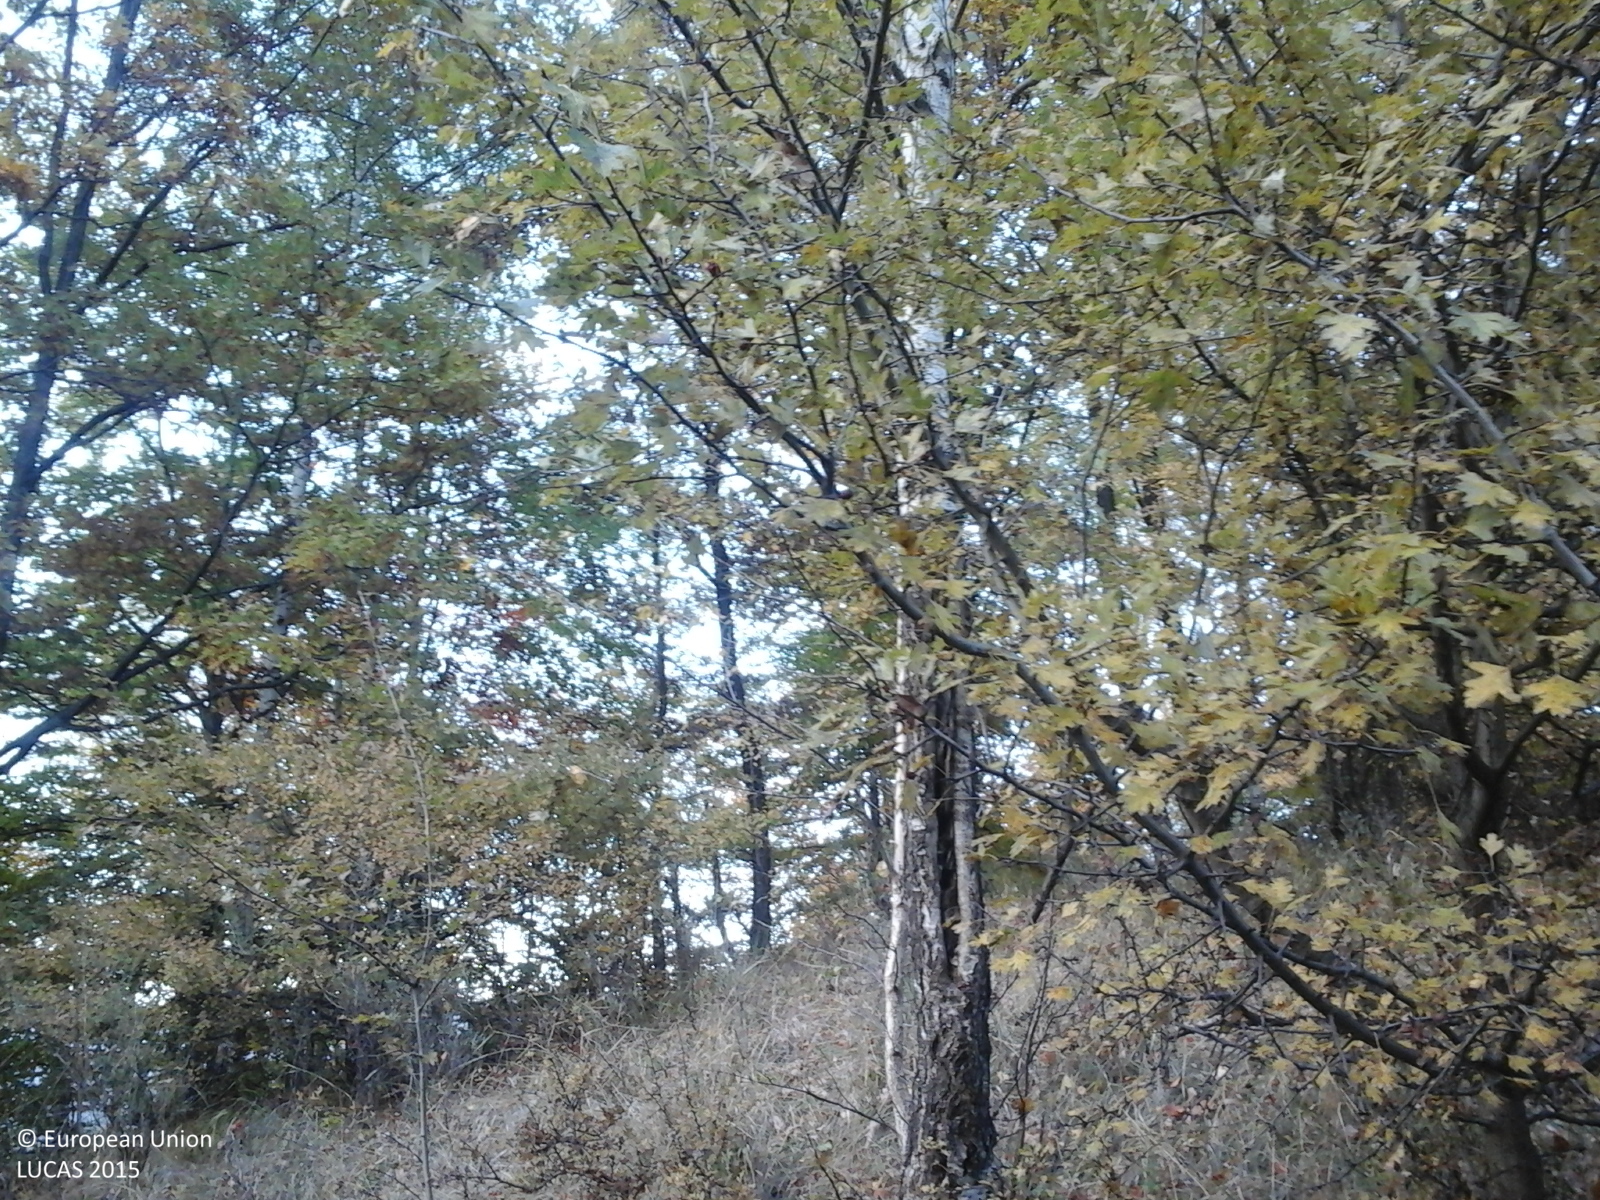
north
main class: Woodland
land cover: Broadleaved woodland
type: non-riverine alder, birch or aspen forest
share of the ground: > 75 %
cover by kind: broadleaved forest trees 100 %
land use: Forestry
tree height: > 5 m
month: October
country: RO
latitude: 45.3641
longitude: 26.4258
